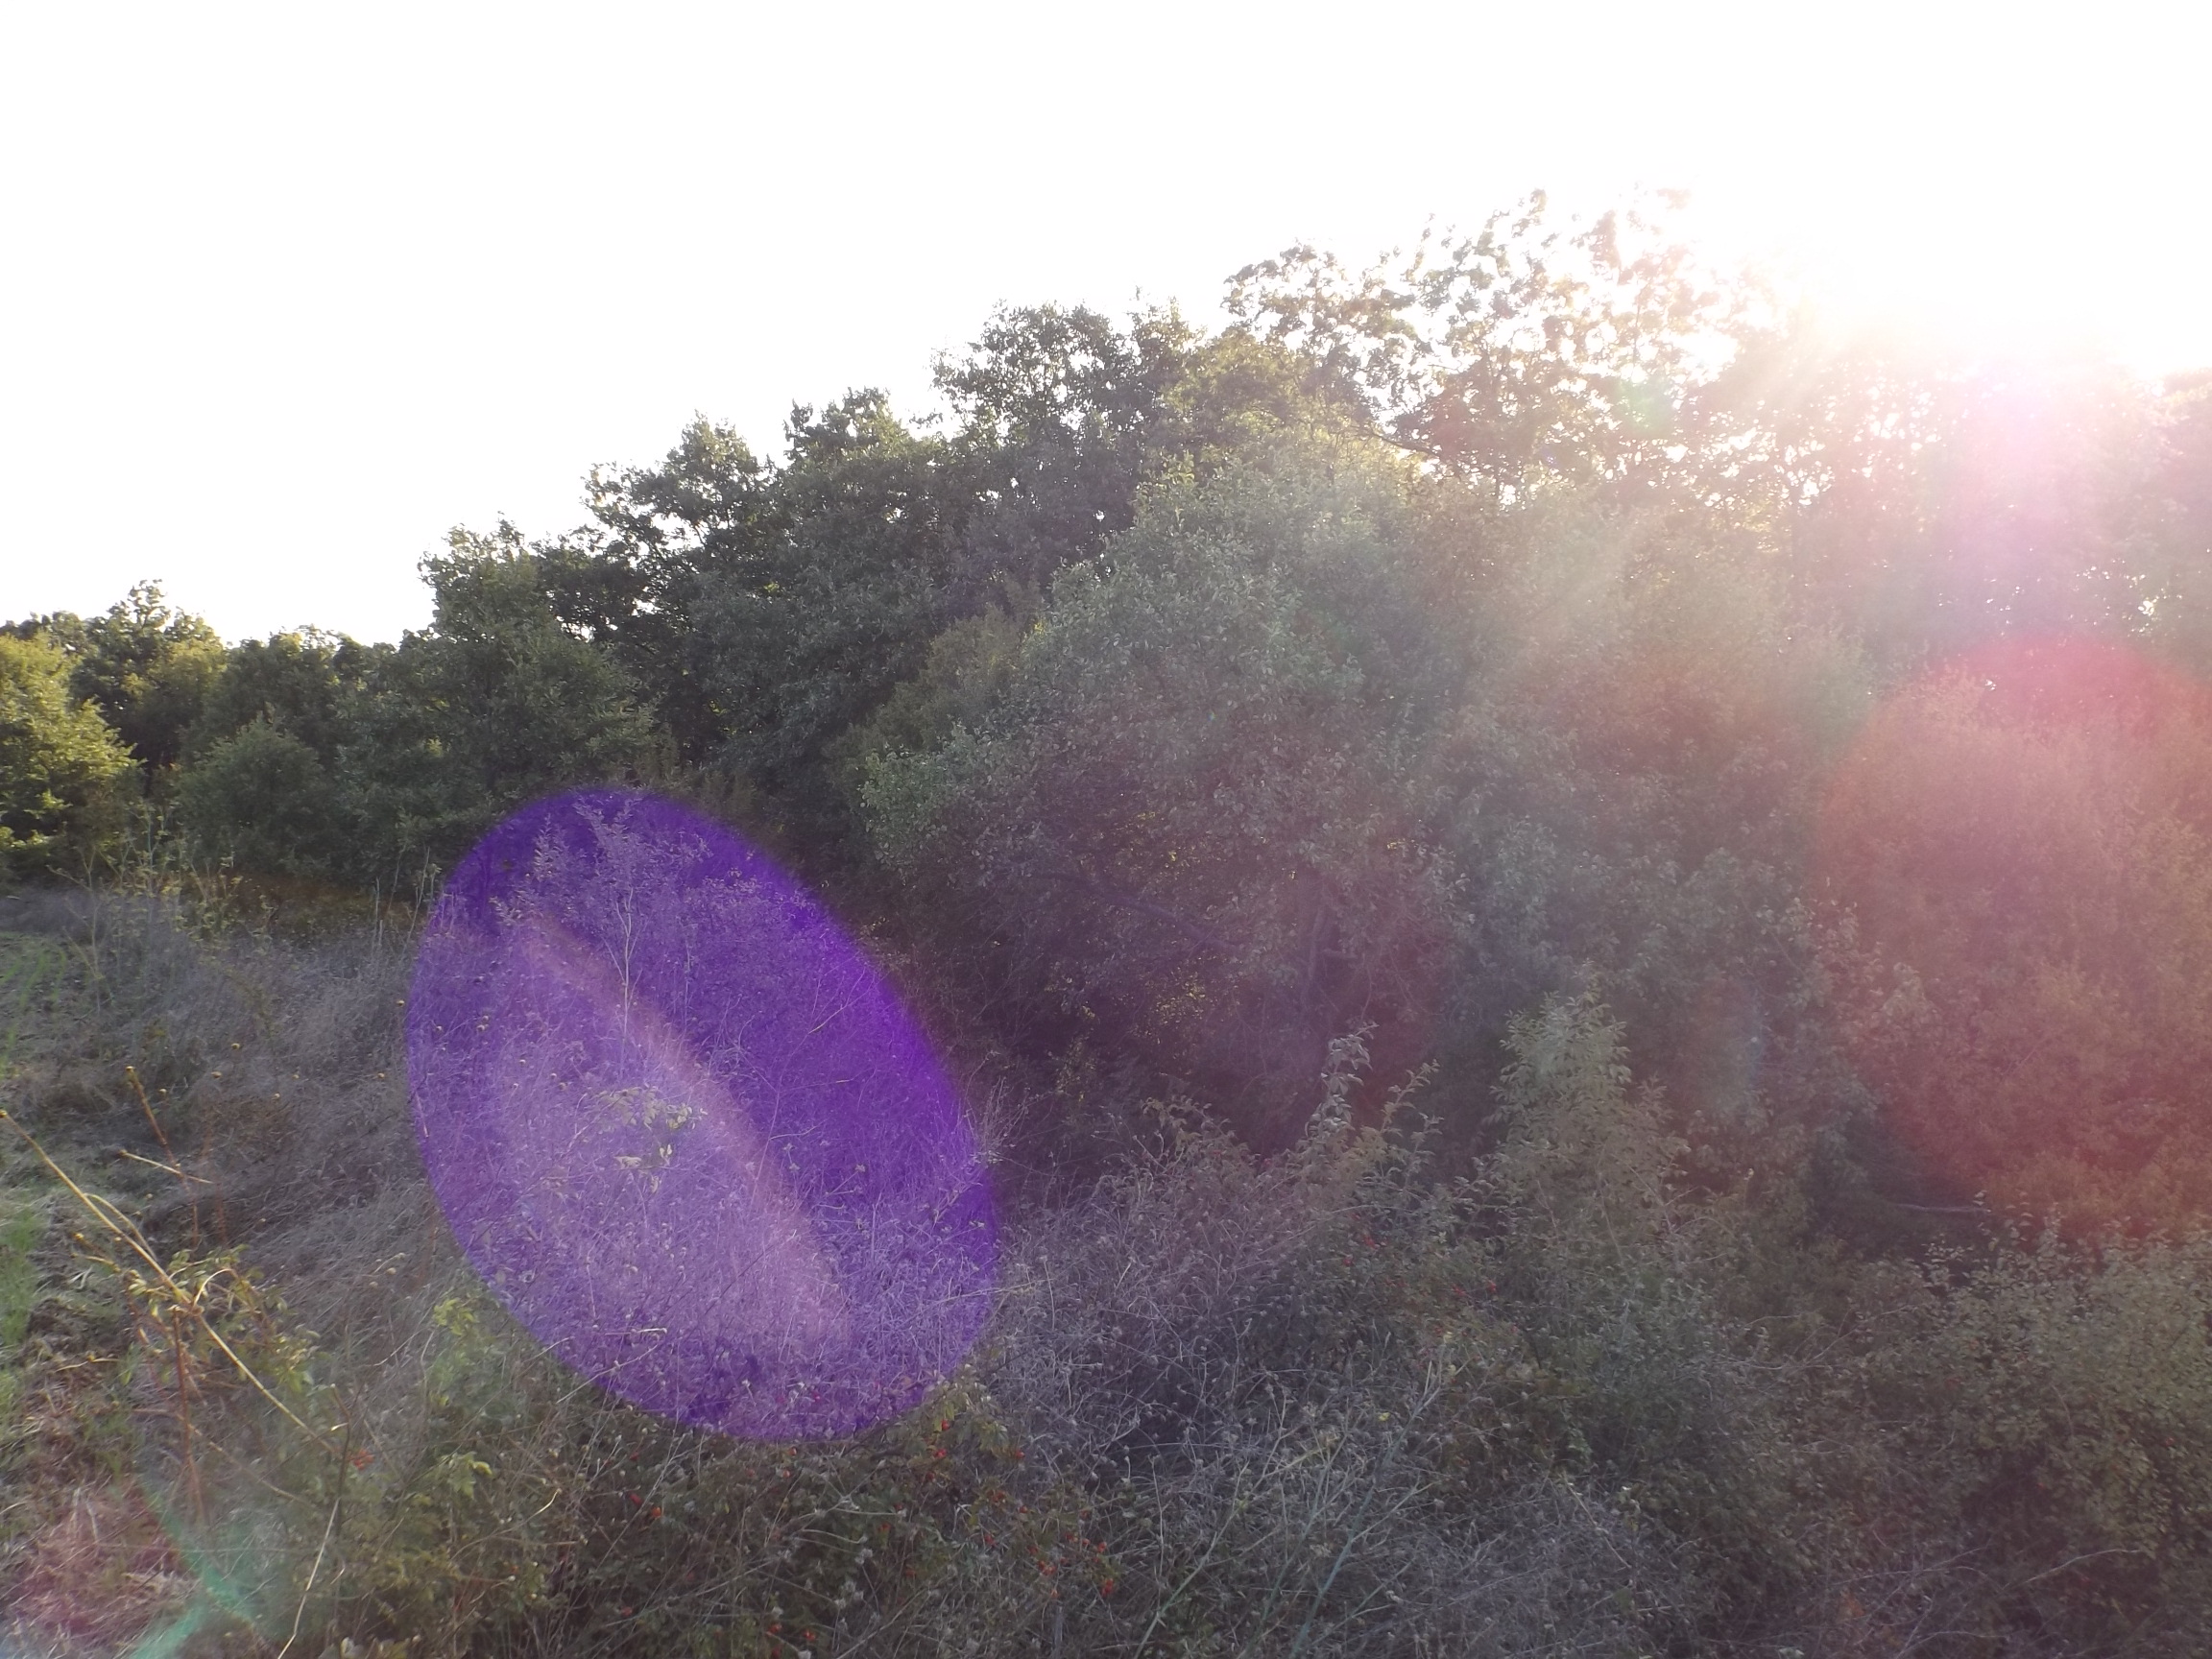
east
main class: Grassland
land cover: Grassland with sparse tree/shrub cover
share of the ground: > 75 %
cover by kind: herbaceous plants 90 %, broadleaved forest trees 5 %, shrubs 5 %
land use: Semi-natural and natural areas not in use
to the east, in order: Grassland with sparse tree/shrub cover; Rivers and streams; Broadleaved woodland; Tracks; Vineyards; Tracks; Grassland with sparse tree/shrub cover; Ditches and canals; Broadleaved woodland
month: October
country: BG
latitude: 42.8931
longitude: 27.8776
